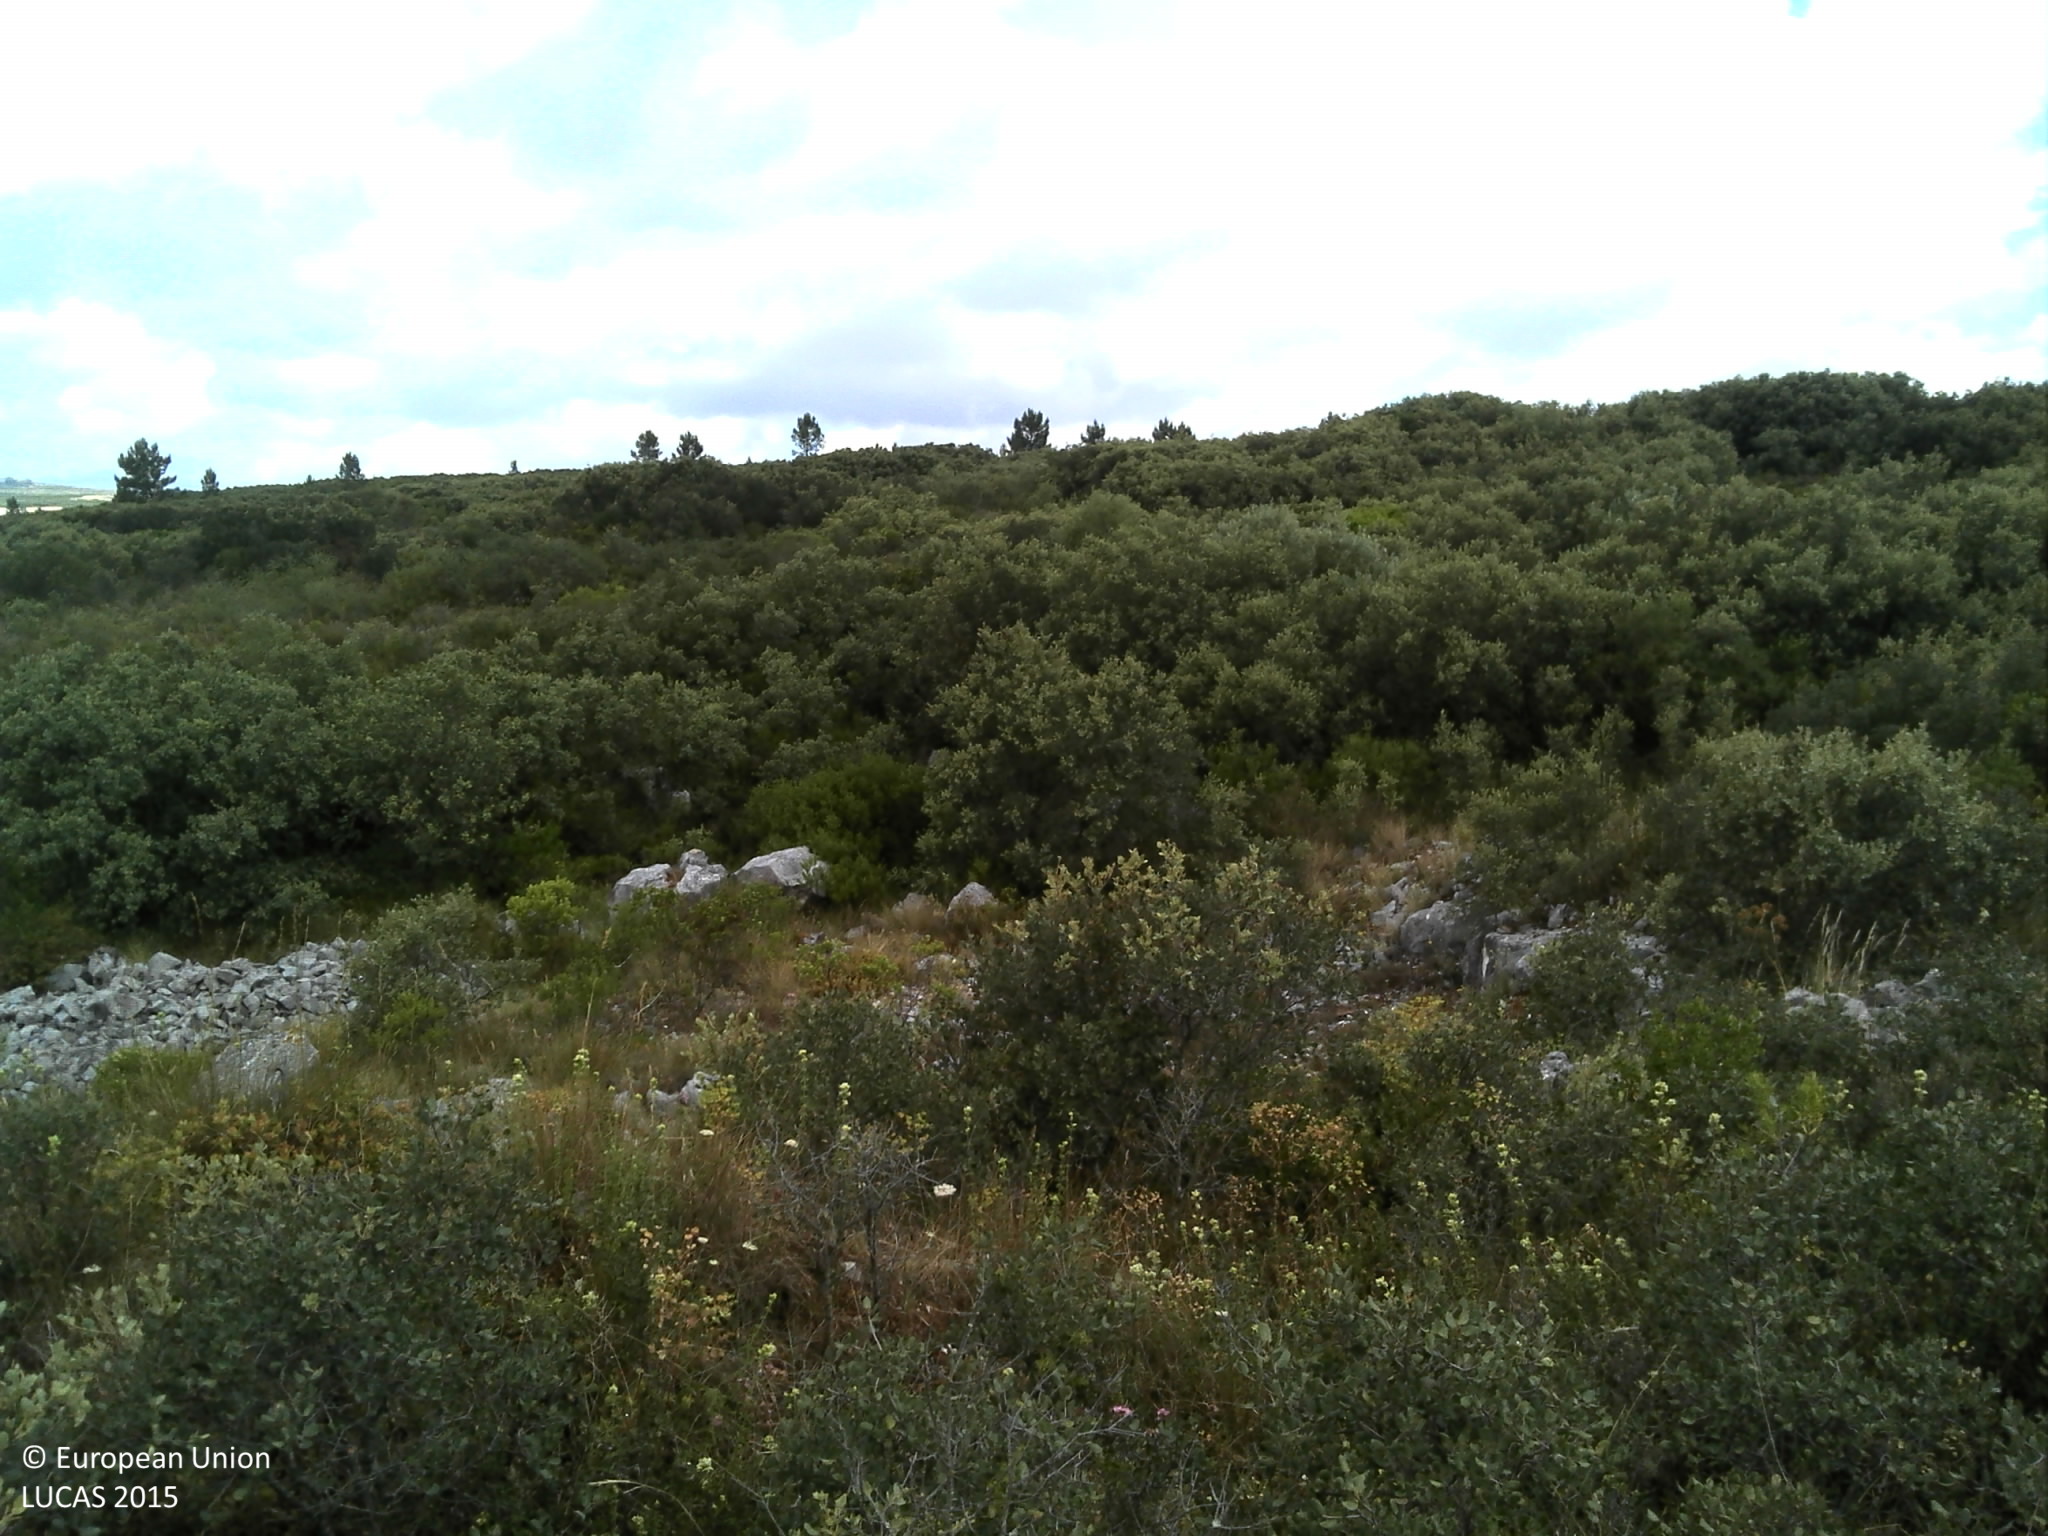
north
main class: Shrubland
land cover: Shrubland with sparse tree cover
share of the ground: 25 - 50 %
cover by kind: shrubs 50 %, unconsolidated bare surface 30 %, herbaceous plants 10 %, broadleaved forest trees 5 %, consolidated bare surface 5 %
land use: Abandoned areas
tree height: < 5 m
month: June
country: PT
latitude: 39.4671
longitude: -8.8059
